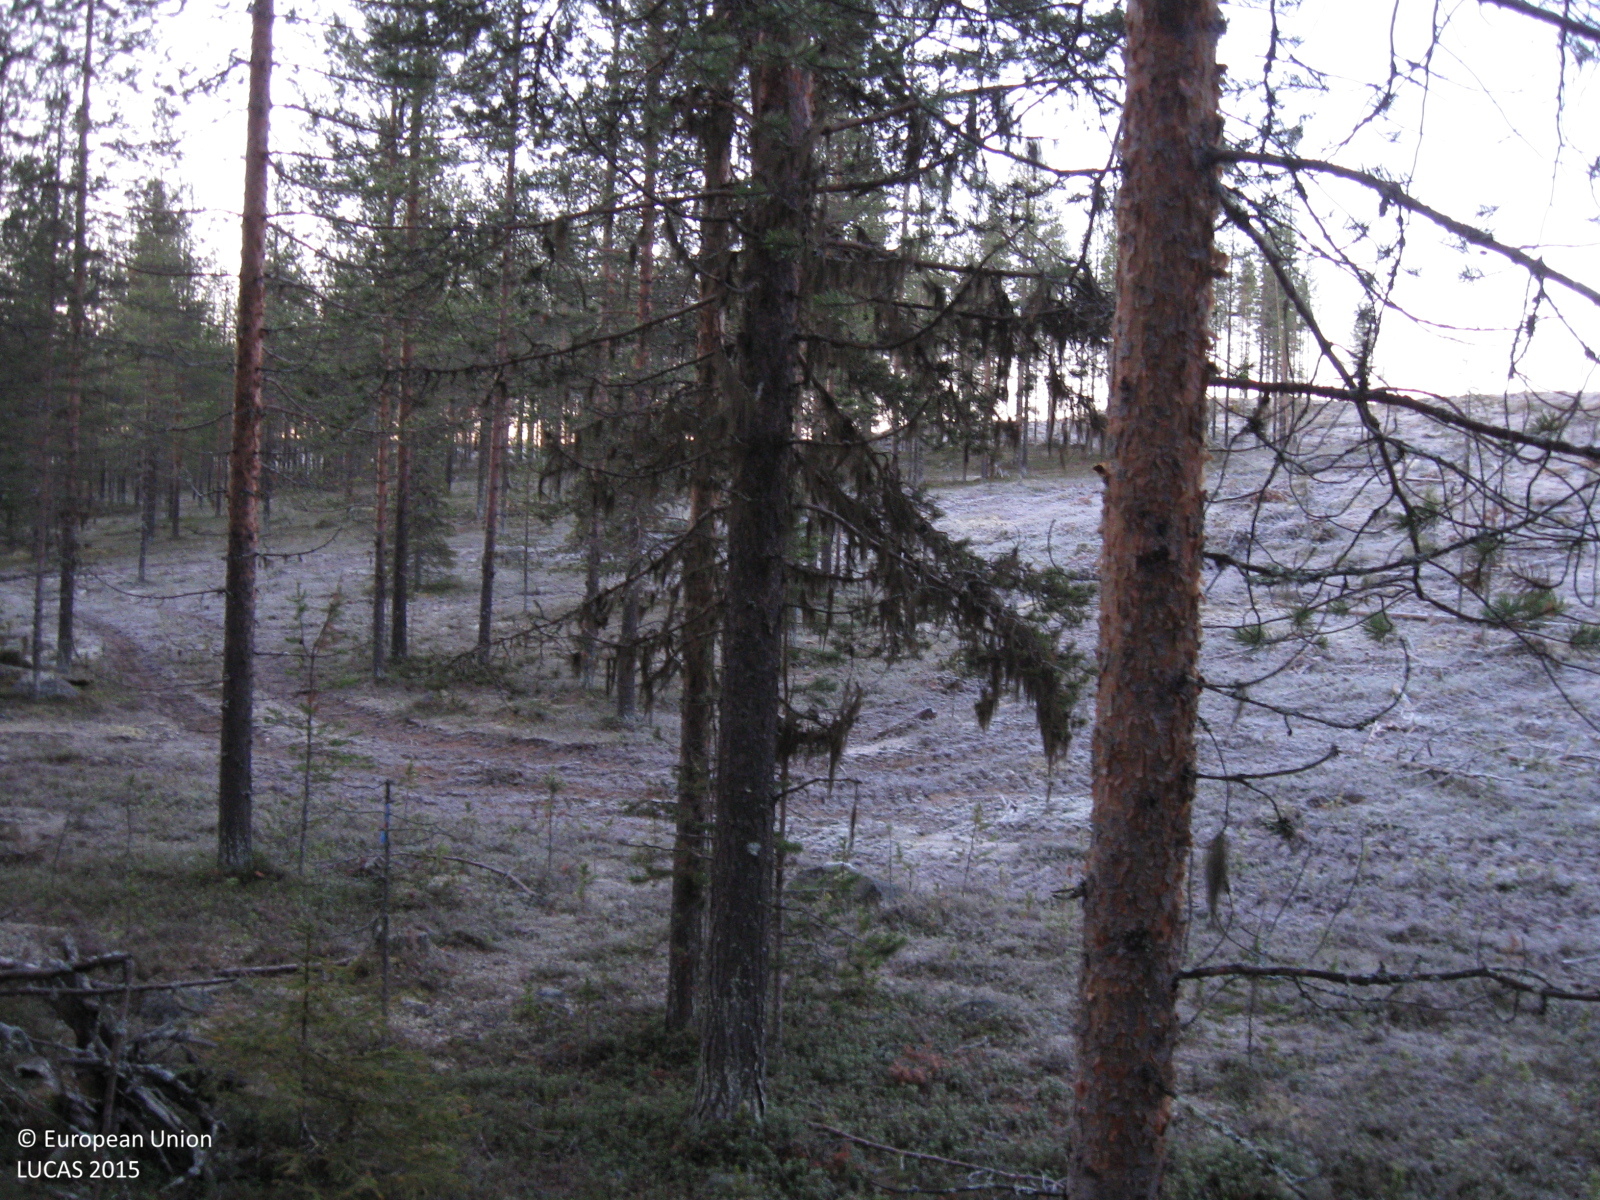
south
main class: Woodland
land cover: Pine dominated coniferous woodland
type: boreal forest
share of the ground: 50 - 75 %
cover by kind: coniferous forest trees 70 %, shrubs 20 %, herbaceous plants 5 %, lichens and mosses 5 %
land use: Forestry
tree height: > 5 m
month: October
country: SE
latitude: 66.4847
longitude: 20.9871
